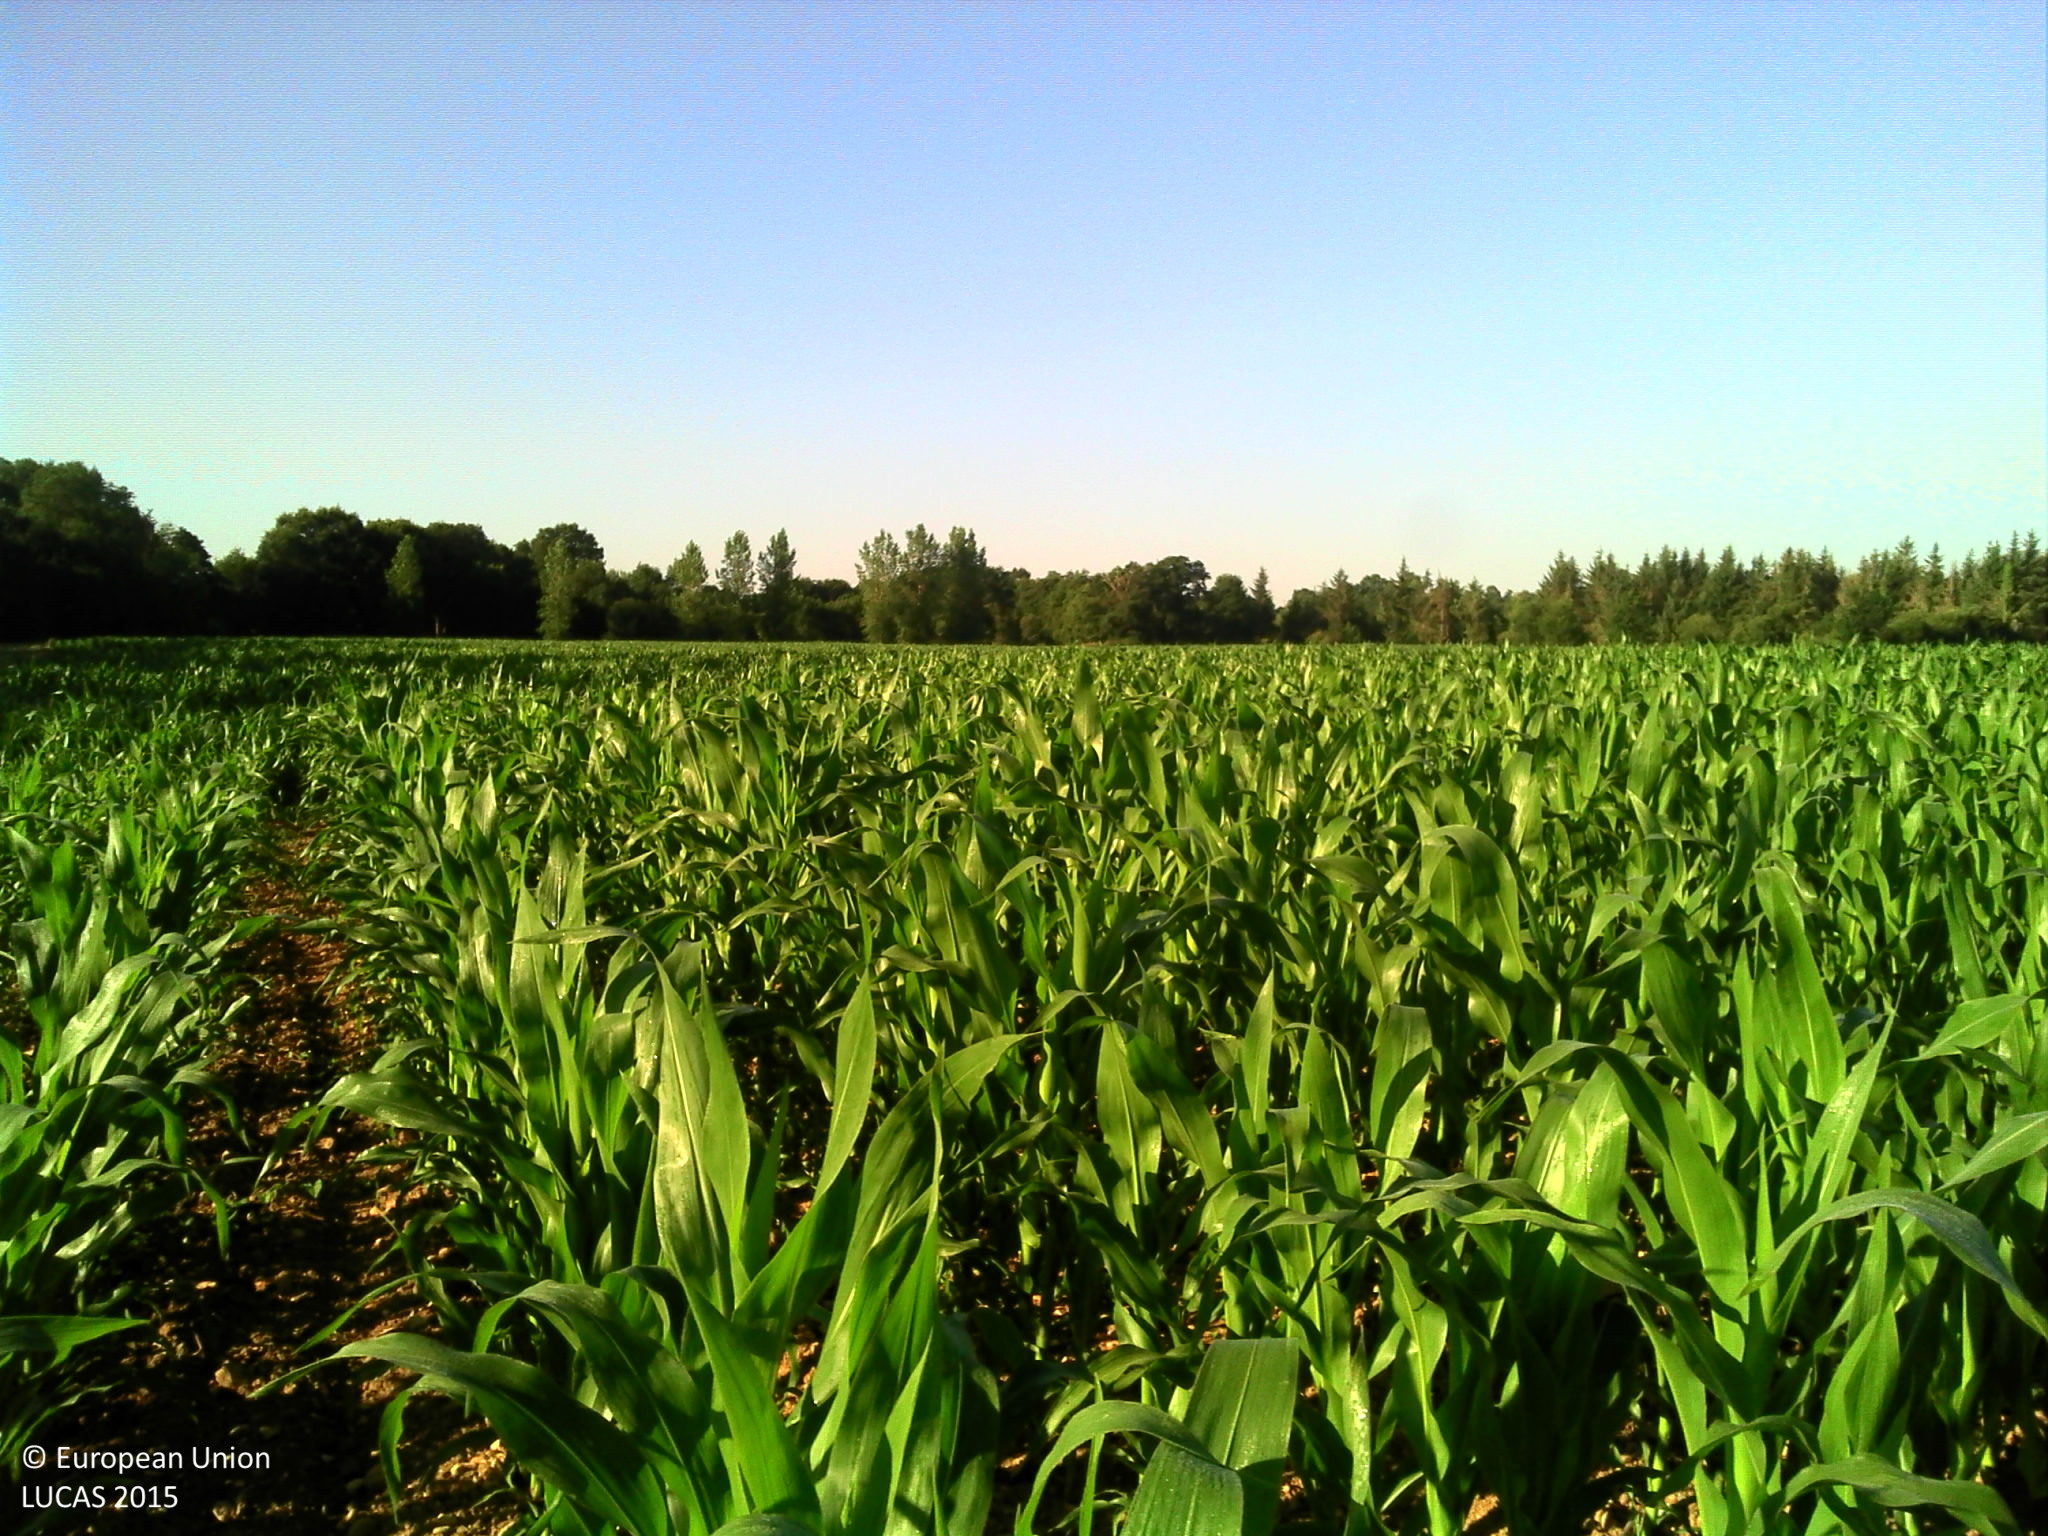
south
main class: Cropland
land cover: Maize
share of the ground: > 75 %
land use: Agriculture (excluding fallow land and kitchen gardens)
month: July
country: FR
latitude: 48.1028
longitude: -1.9092
